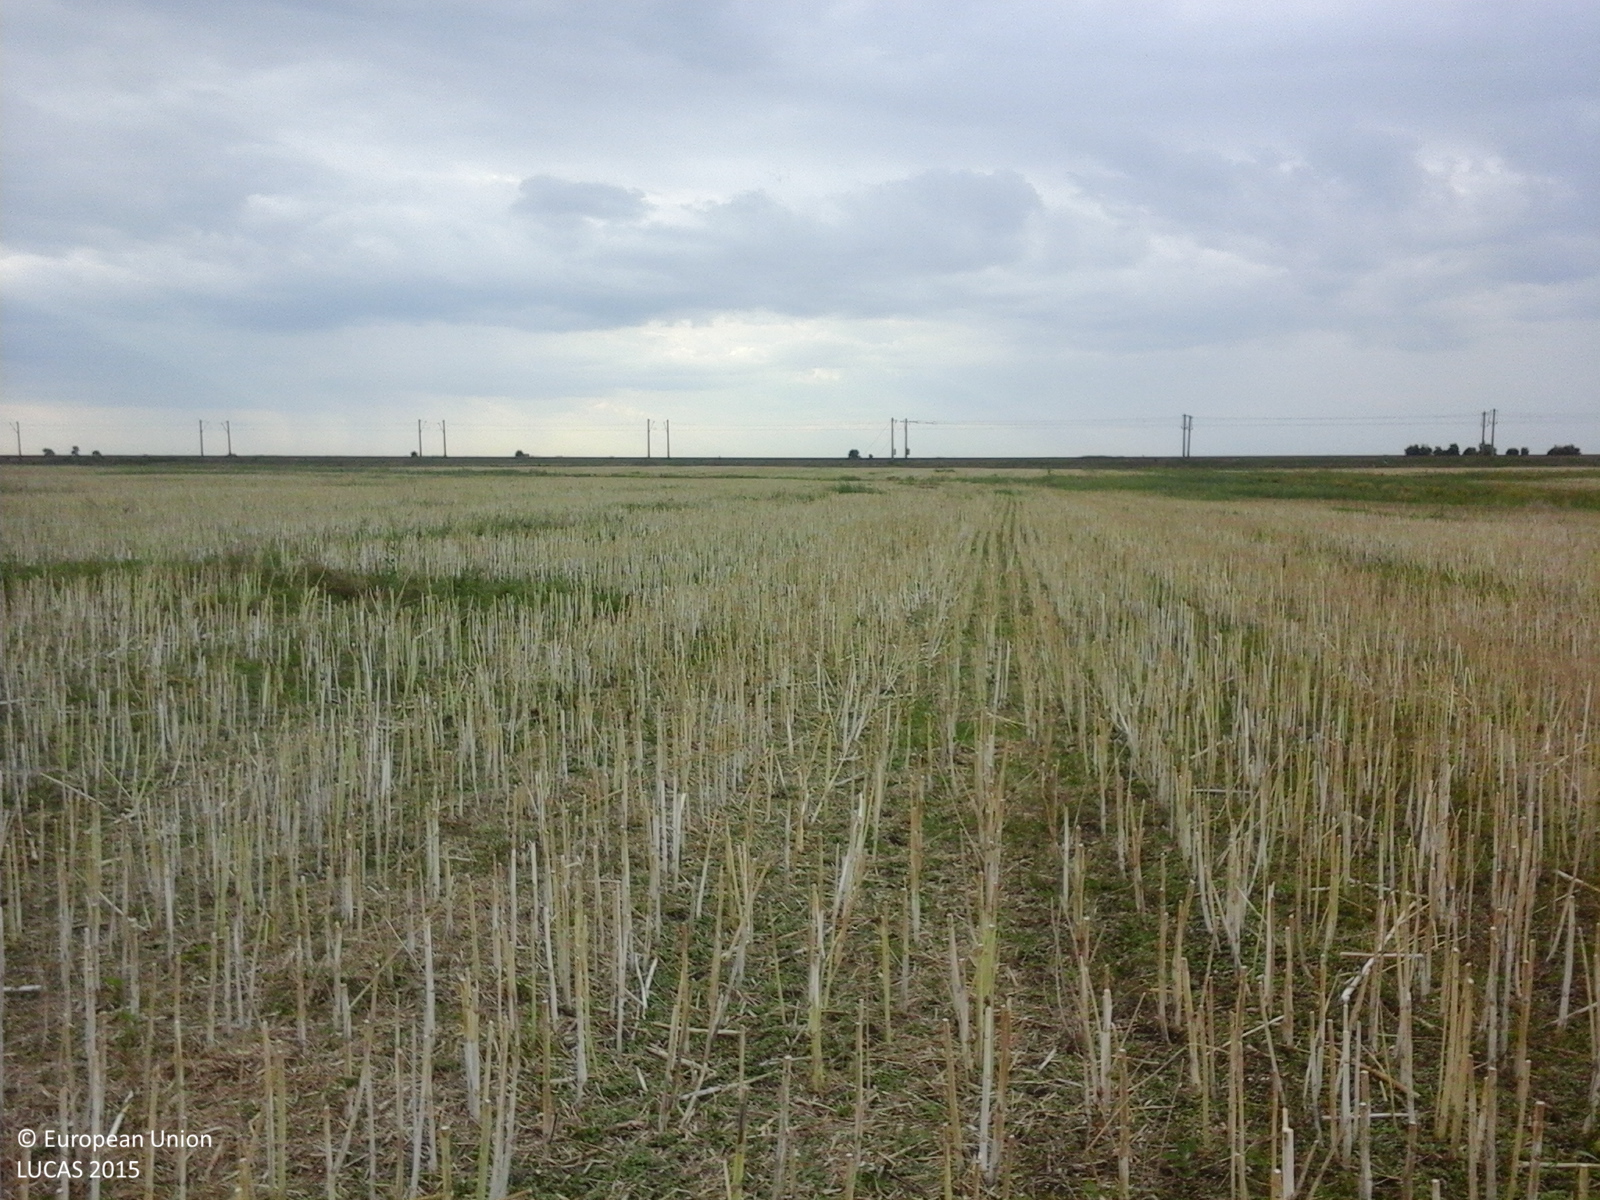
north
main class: Cropland
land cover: Rape and turnip rape
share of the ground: < 10 %
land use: Agriculture (excluding fallow land and kitchen gardens)
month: July
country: RO
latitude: 44.1201
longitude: 24.8320
